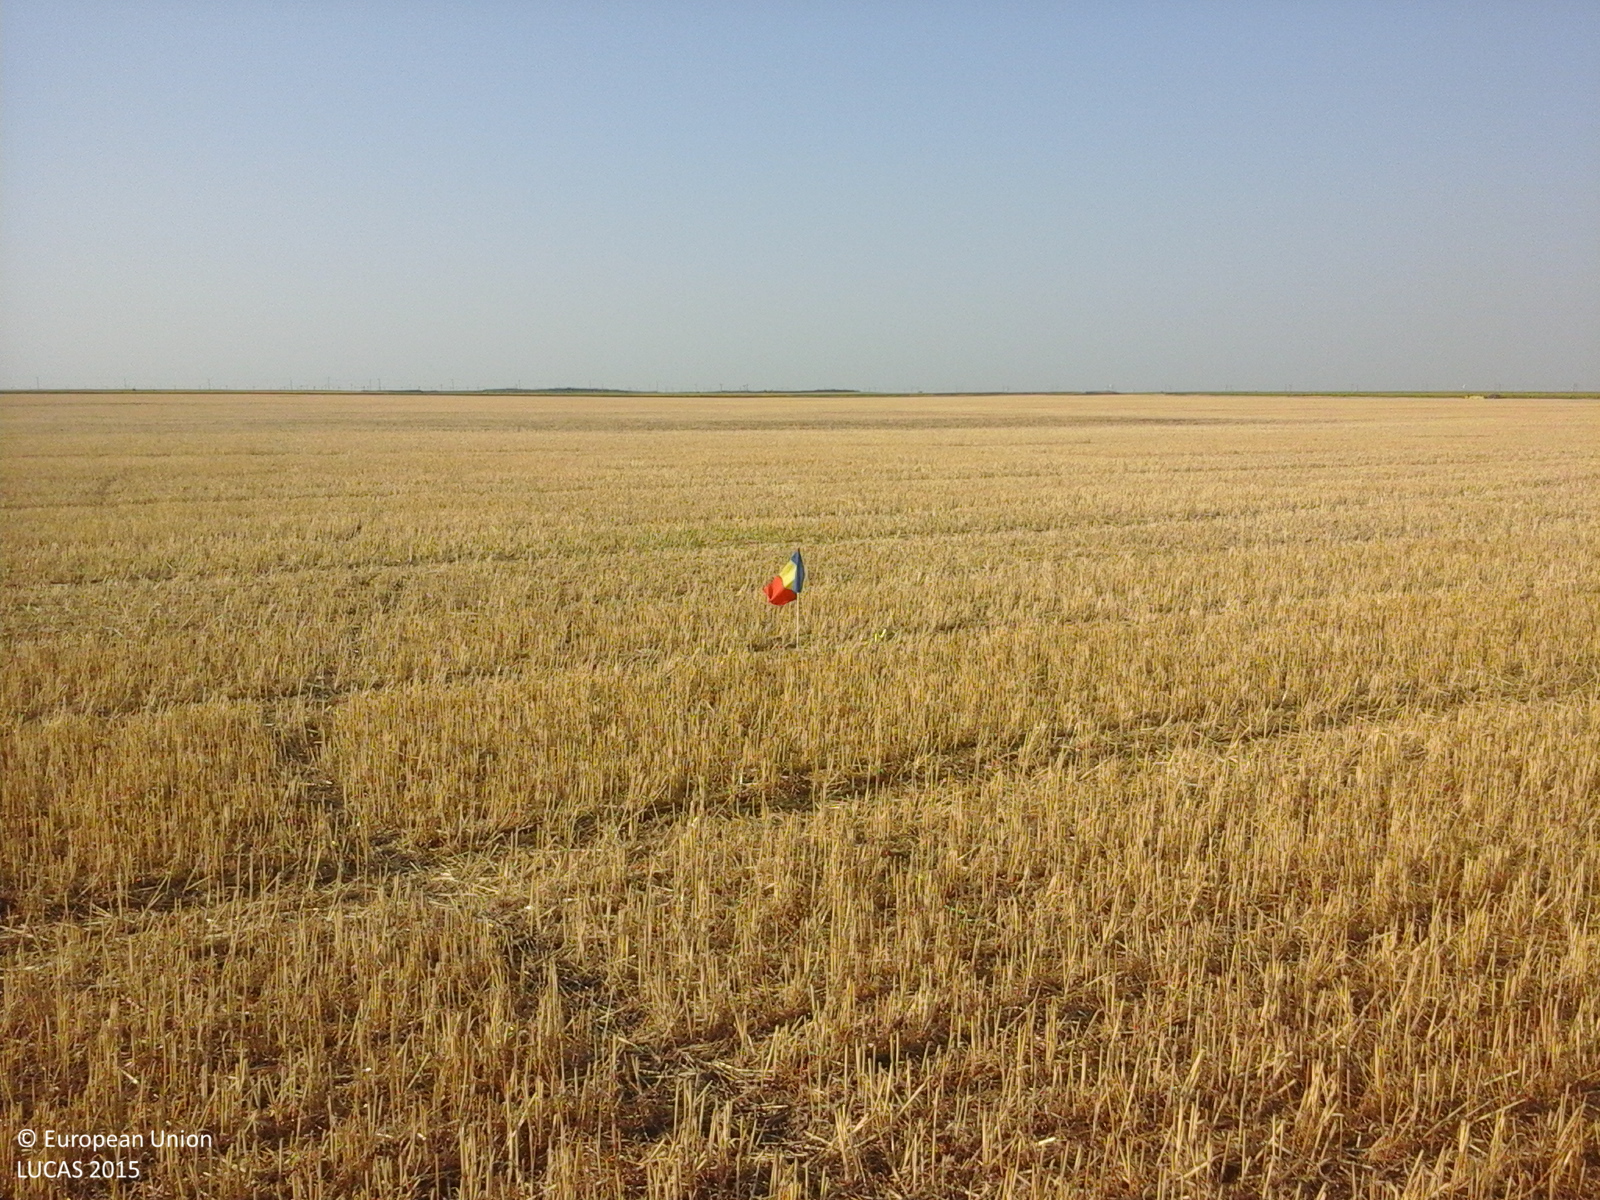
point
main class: Cropland
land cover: Common wheat
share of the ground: < 10 %
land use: Agriculture (excluding fallow land and kitchen gardens)
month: July
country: RO
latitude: 44.9960
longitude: 27.3316
